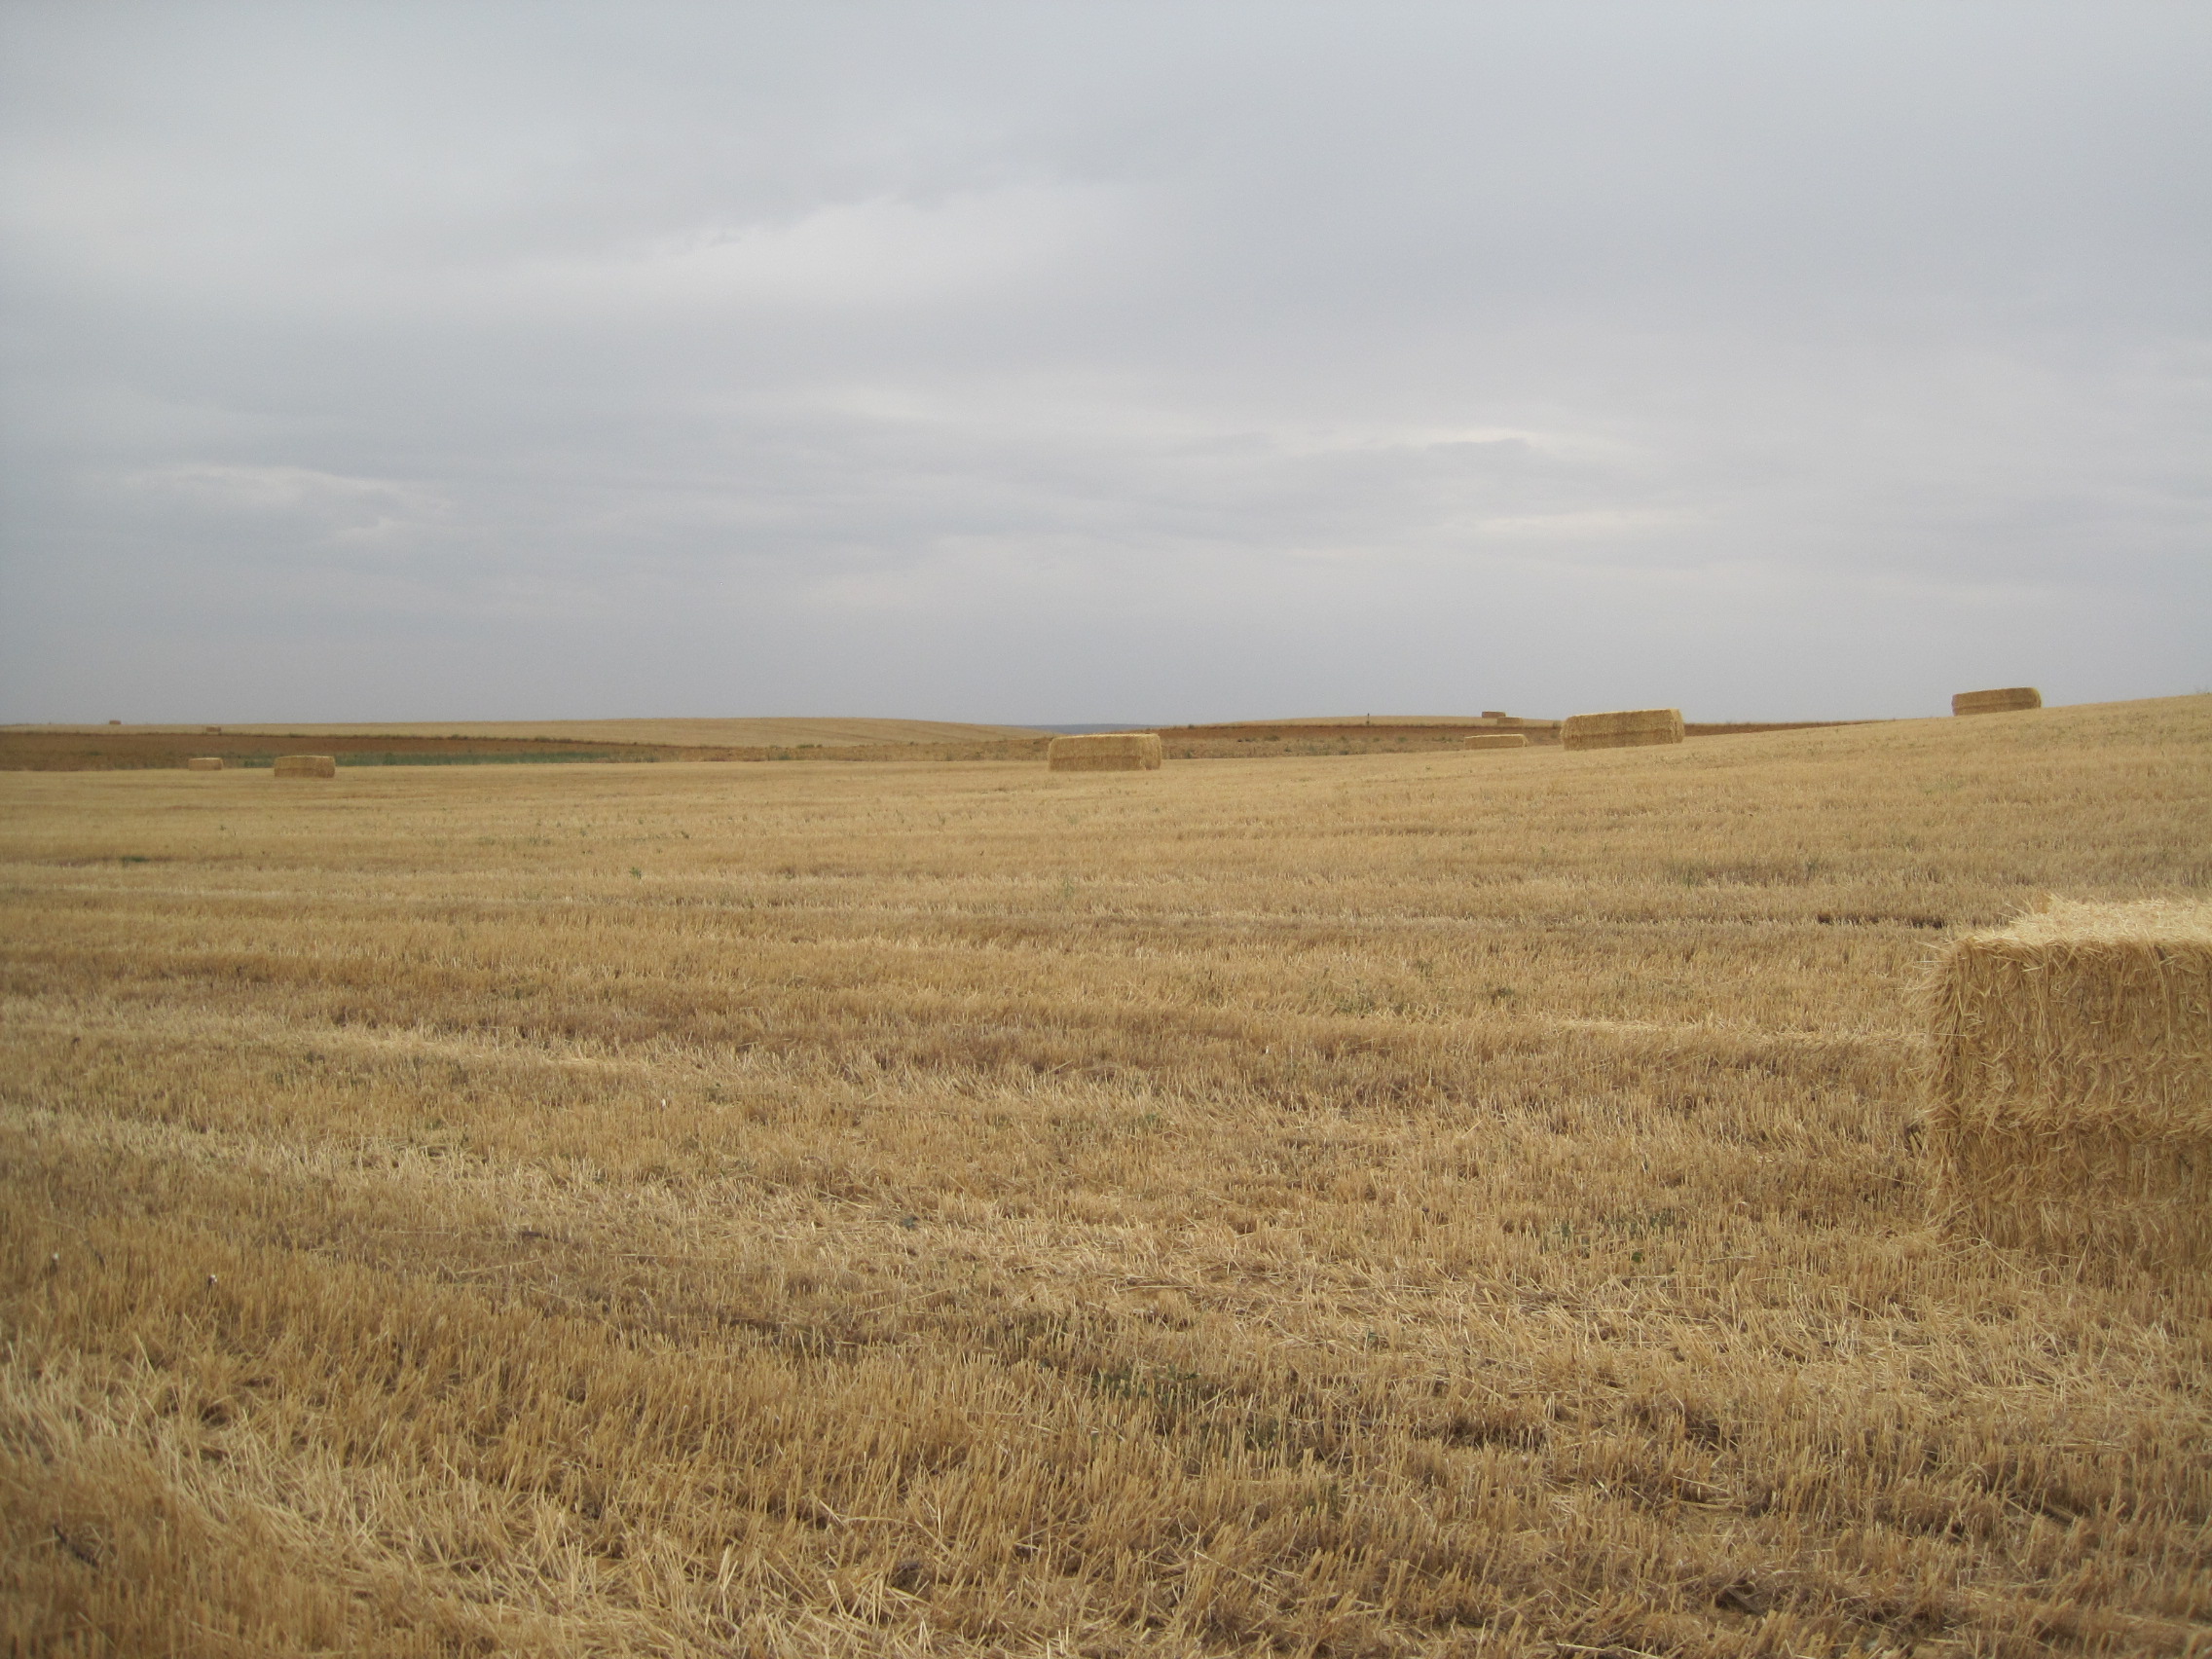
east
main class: Cropland
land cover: Barley
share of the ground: < 10 %
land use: Agriculture (excluding fallow land and kitchen gardens)
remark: Harvested field
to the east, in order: Barley; Grass margins; Other bare soil; Grass margins; Other bare soil
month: July
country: ES
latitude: 41.7934
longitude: -5.5500
